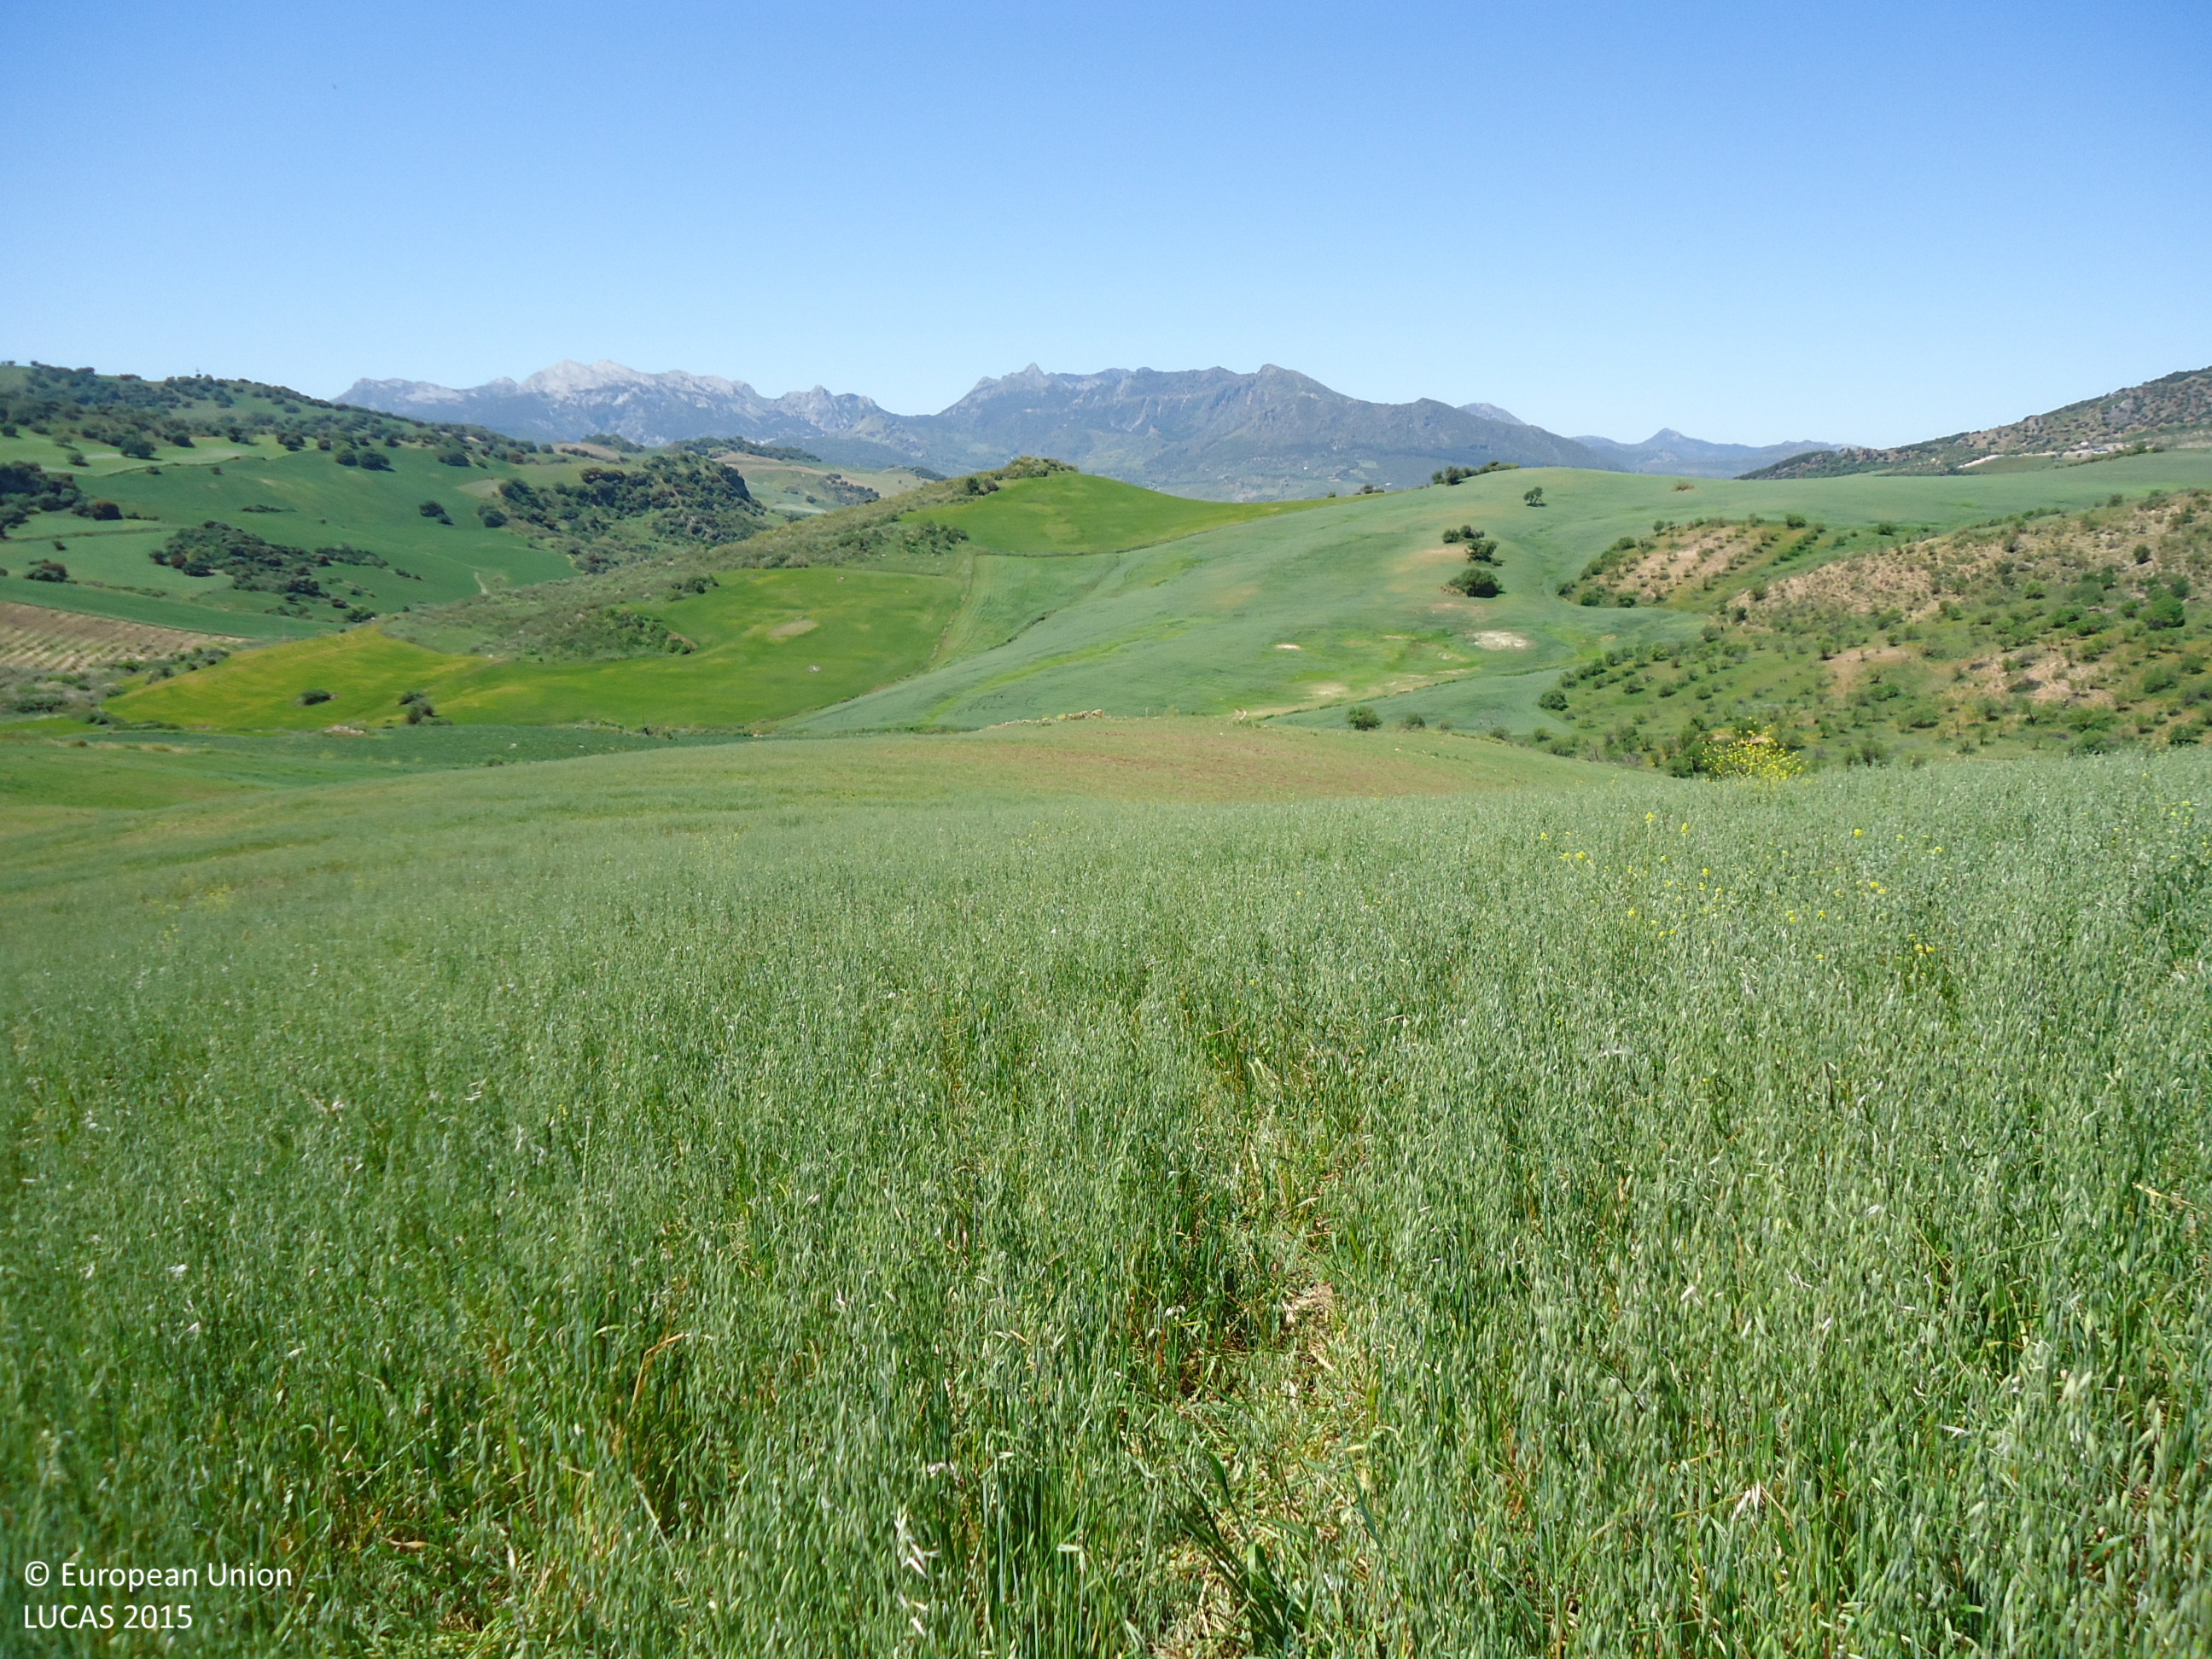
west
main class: Cropland
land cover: Oats
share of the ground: > 75 %
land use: Agriculture (excluding fallow land and kitchen gardens)
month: May
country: ES
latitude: 36.8212
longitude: -5.2599
